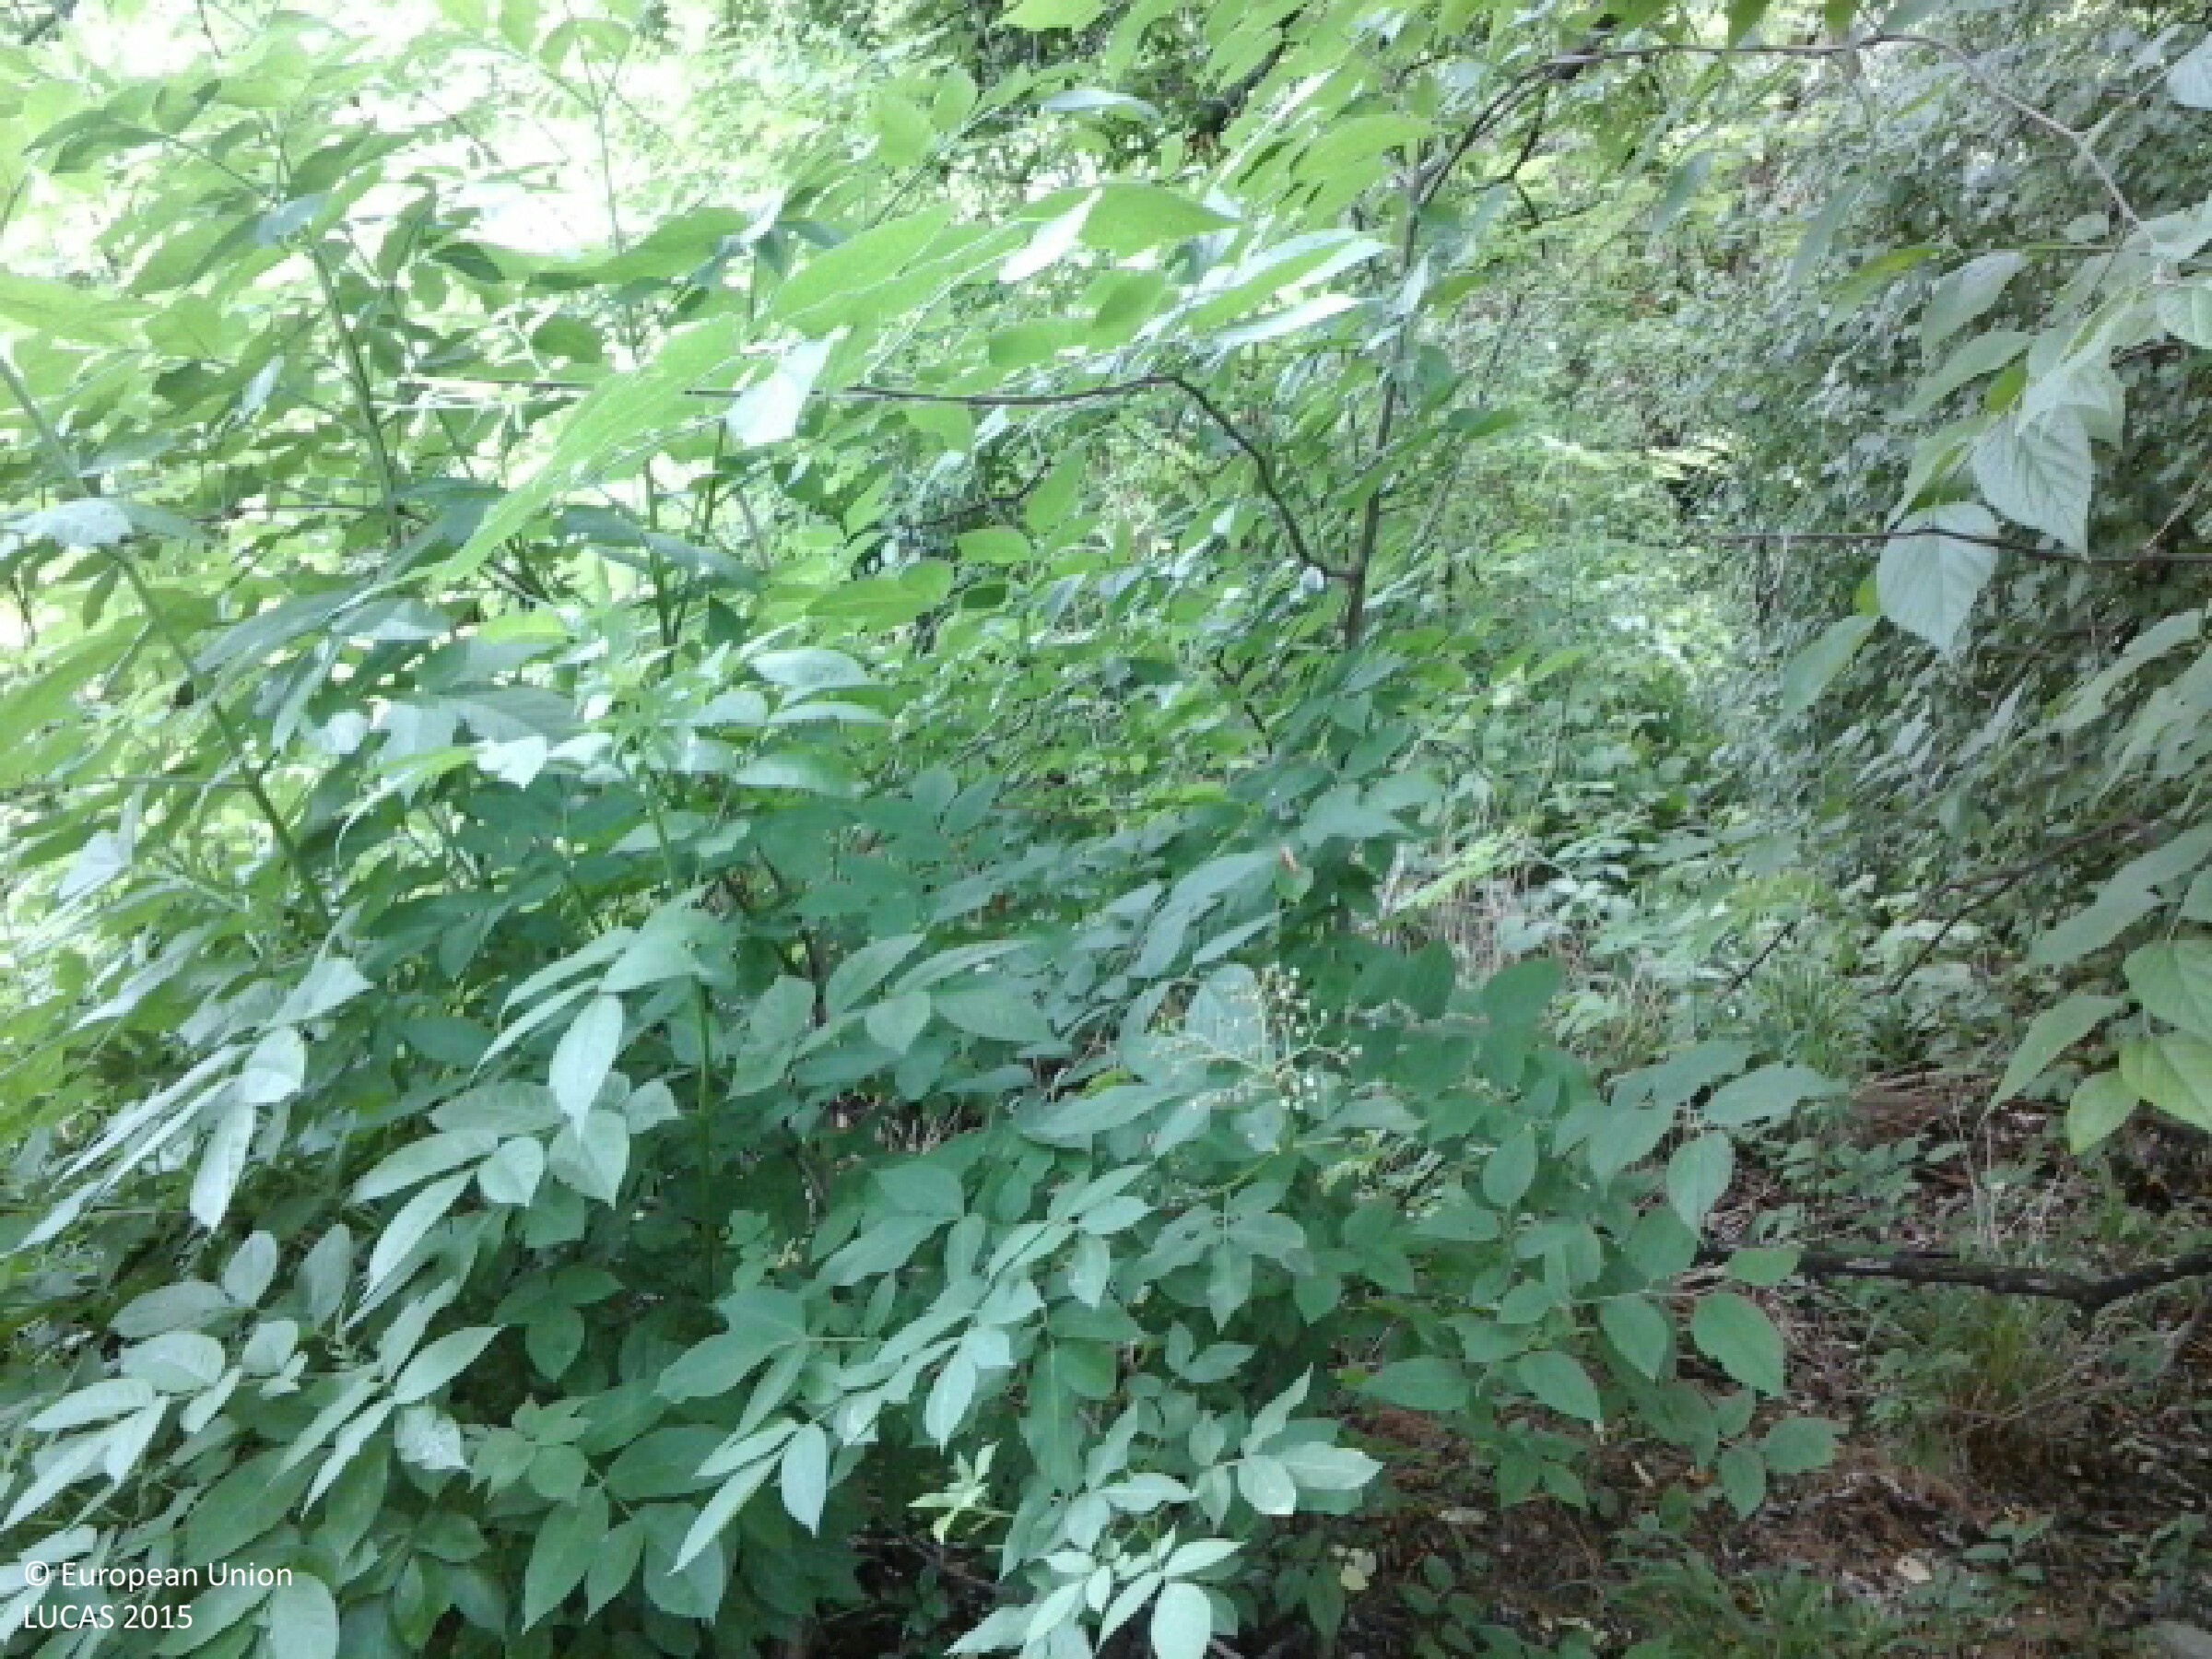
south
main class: Woodland
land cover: Broadleaved woodland
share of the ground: > 75 %
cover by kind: broadleaved forest trees 90 %, shrubs 5 %, herbaceous plants 5 %
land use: Forestry
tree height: > 5 m
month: June
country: HU
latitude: 47.9341
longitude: 21.7879
